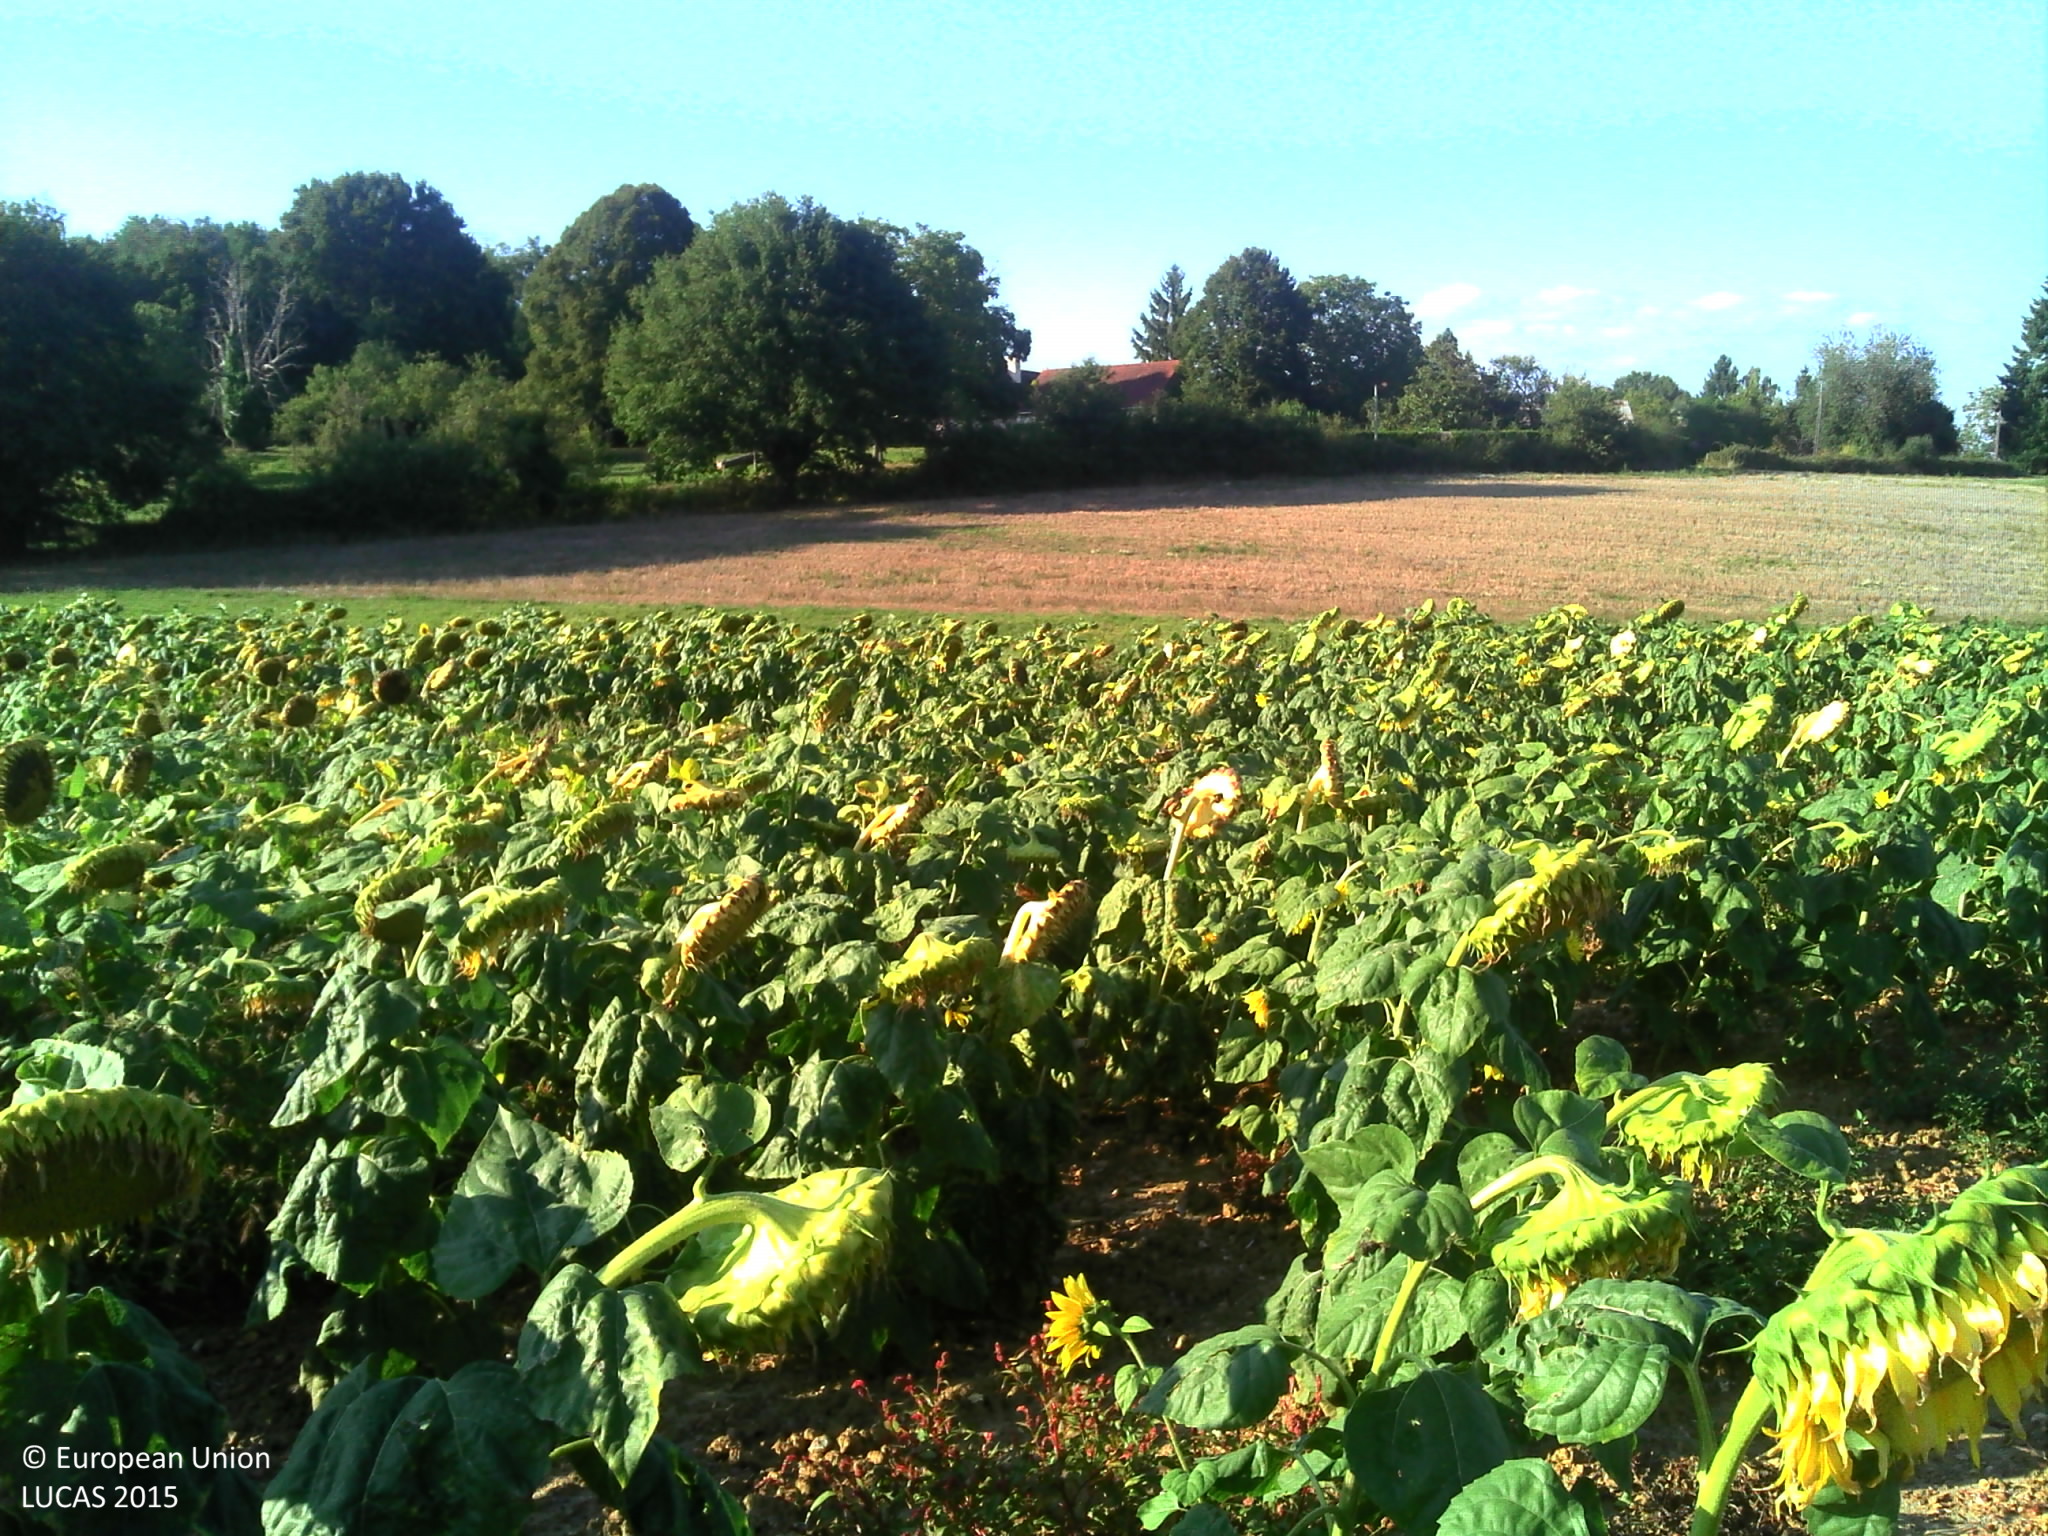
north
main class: Cropland
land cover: Sunflower
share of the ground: > 75 %
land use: Agriculture (excluding fallow land and kitchen gardens)
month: September
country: FR
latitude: 47.0442
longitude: 1.4982
